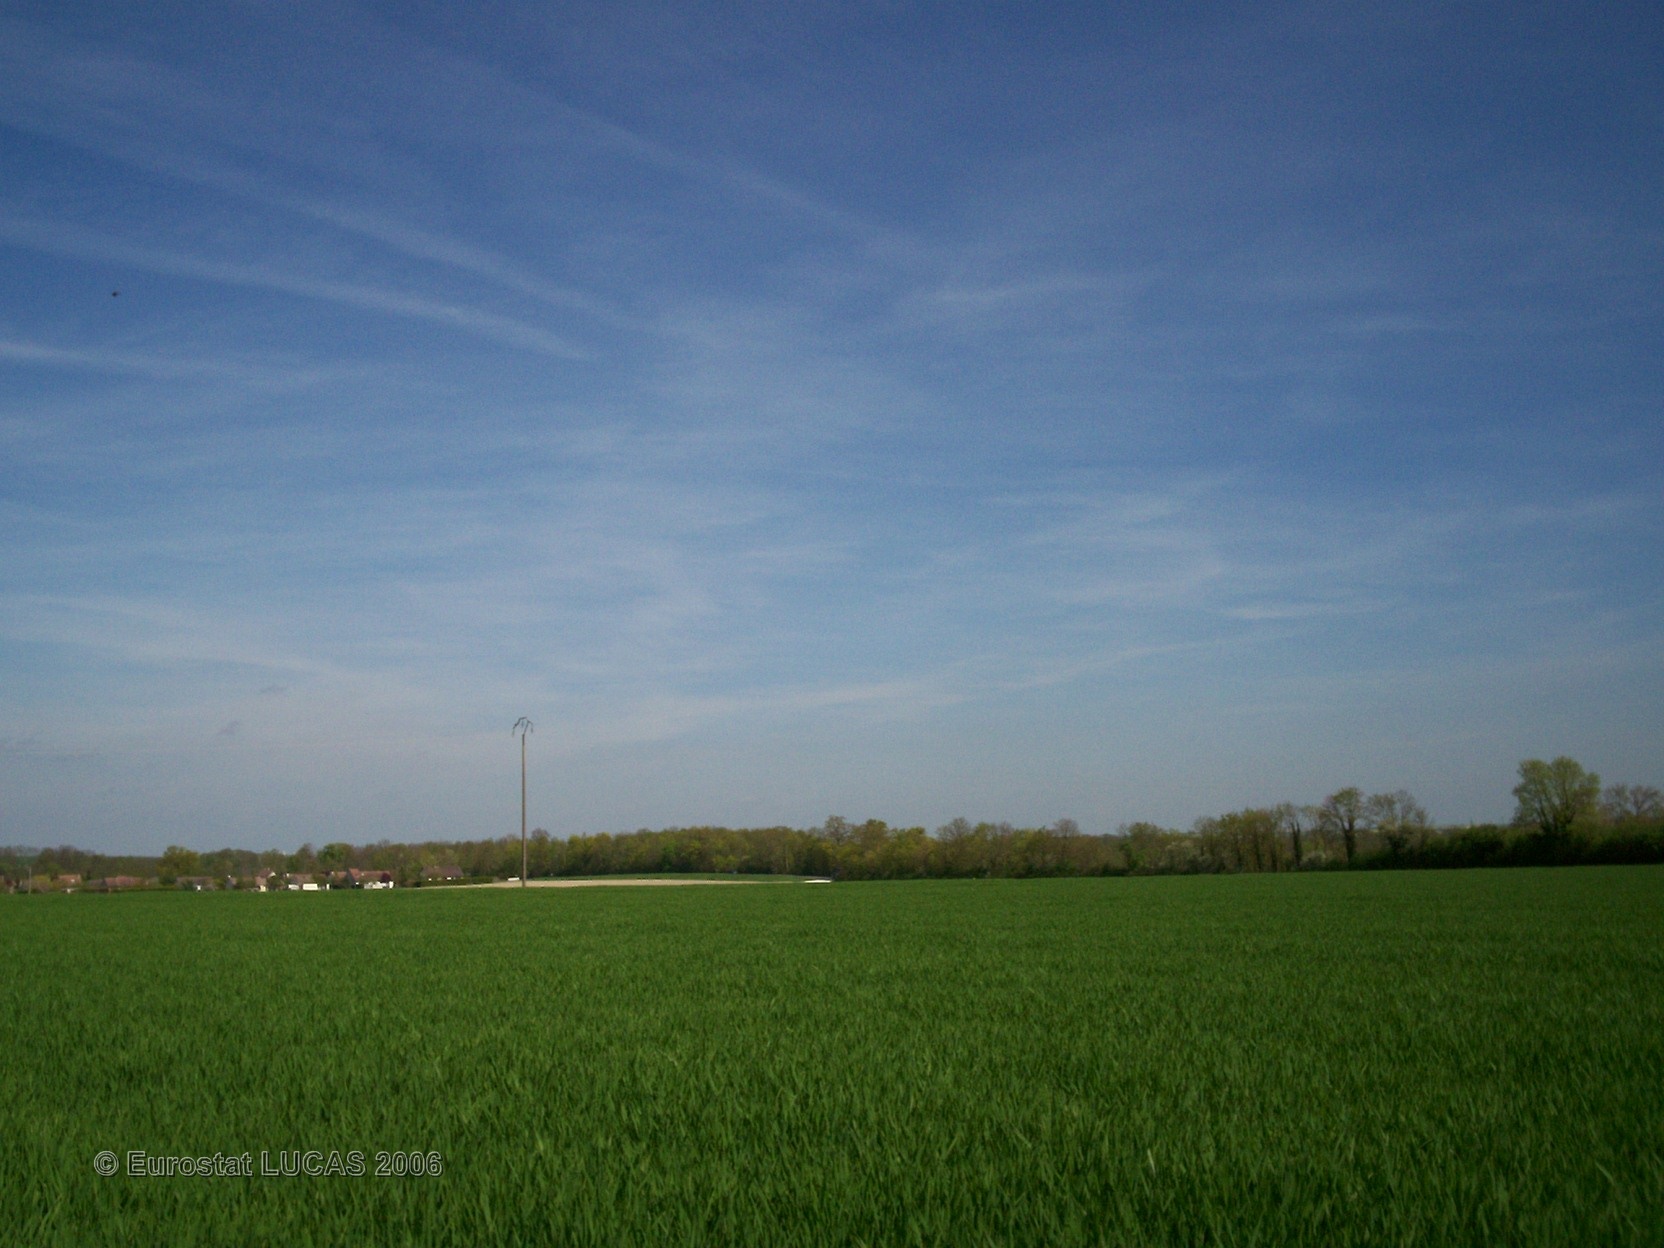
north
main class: Cropland
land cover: Barley
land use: Agriculture (excluding fallow land and kitchen gardens)
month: May
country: FR
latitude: 48.8758
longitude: 4.4199
